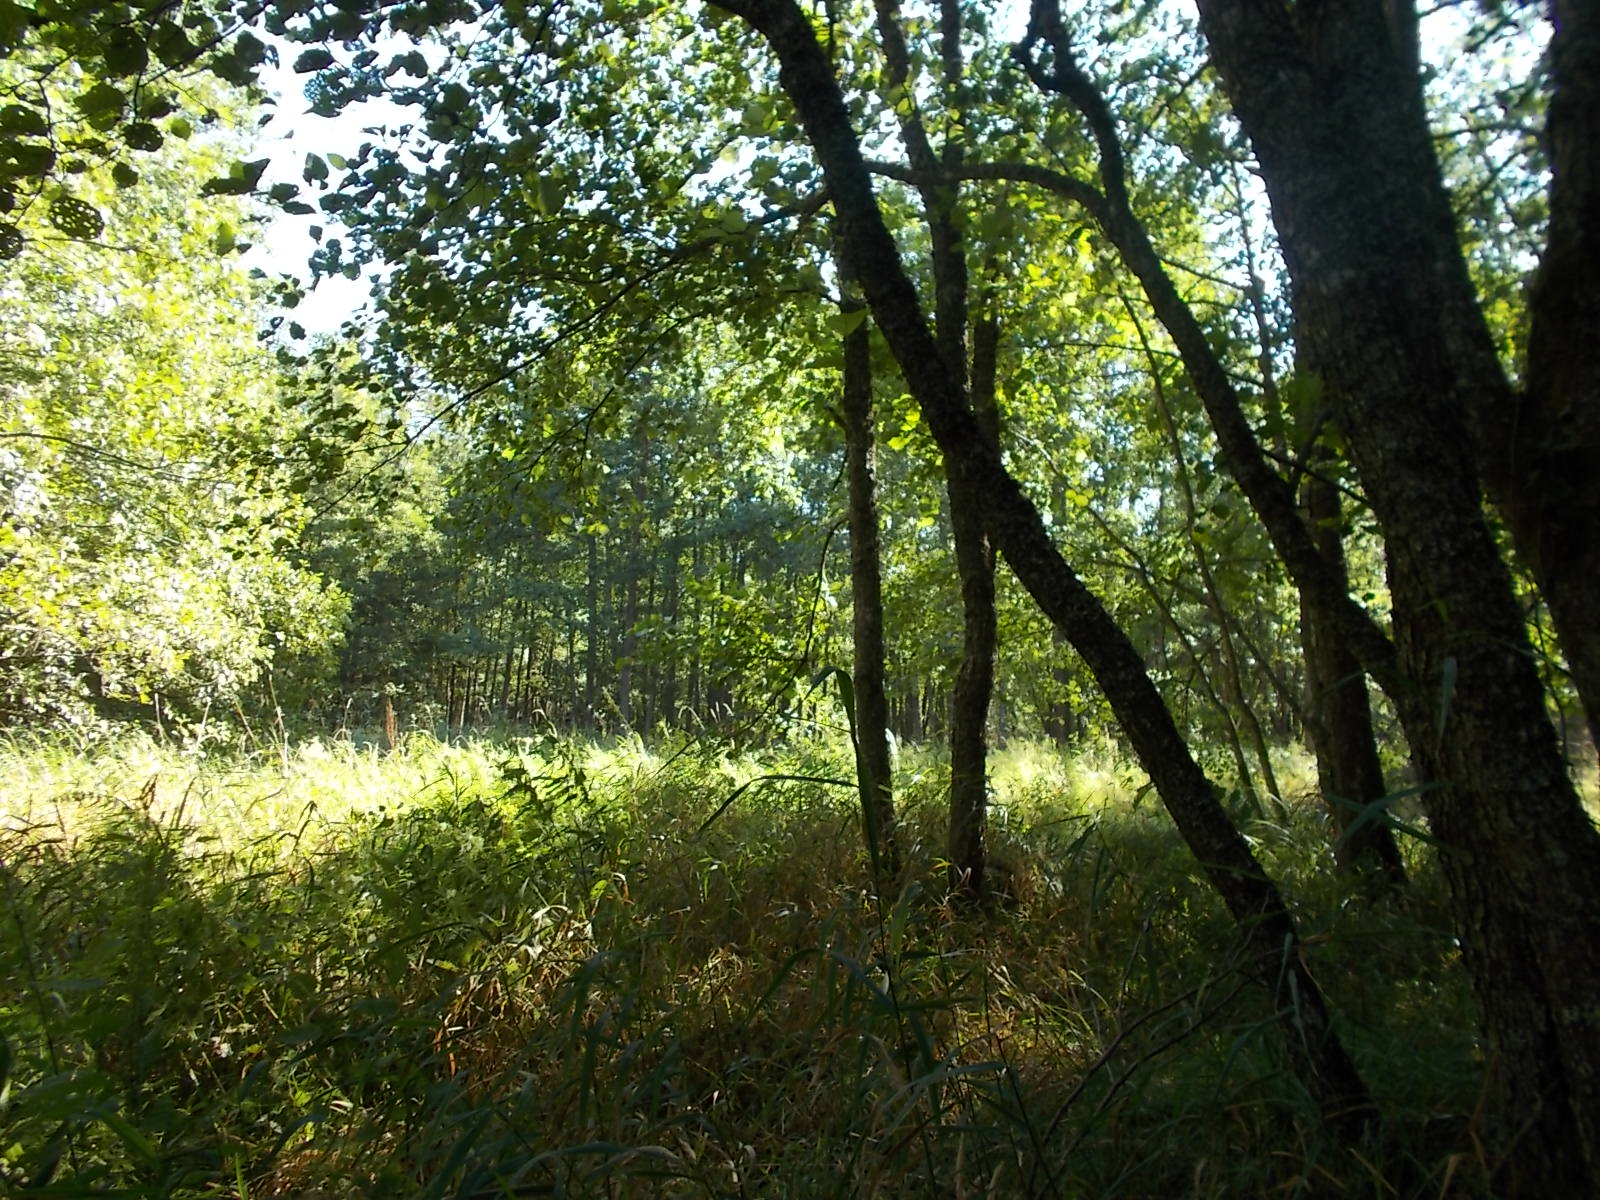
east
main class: Woodland
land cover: Spruce dominated mixed woodland
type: hemiboreal forest and nemoral coniferous forest and mixed broadleaved-coniferous forest
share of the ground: 50 - 75 %
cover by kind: broadleaved forest trees 40 %, coniferous forest trees 30 %, shrubs 10 %, herbaceous plants 10 %
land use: Forestry
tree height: > 5 m
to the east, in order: Spruce dominated mixed woodland; Rivers and streams; Broadleaved woodland; Spruce dominated mixed woodland; Broadleaved woodland
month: September
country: LV
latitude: 57.2195
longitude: 21.8517
